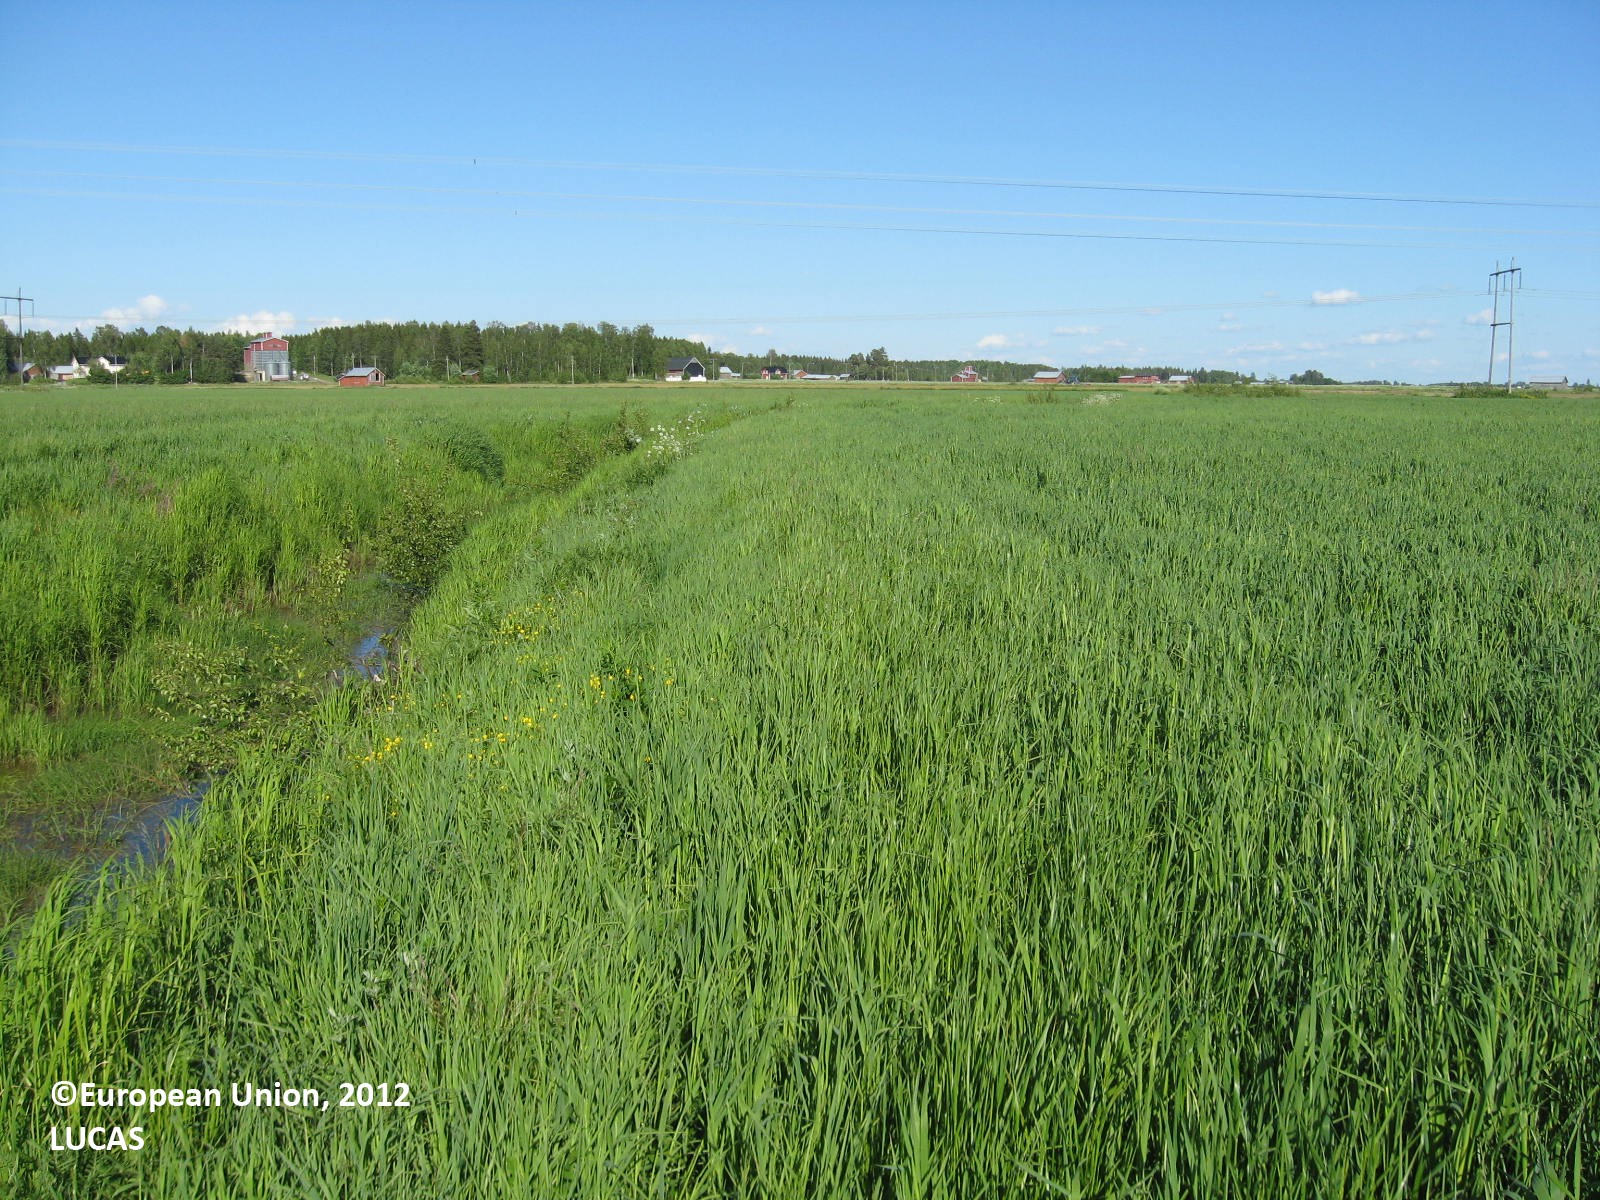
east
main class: Cropland
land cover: Temporary grasslands
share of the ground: > 75 %
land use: Agriculture (excluding fallow land and kitchen gardens)
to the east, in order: Temporary grasslands; Grass margins; Ditches and canals; Grass margins; Temporary grasslands; Electric lines; Barley; Electric lines; Barley
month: June
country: FI
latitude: 63.0030
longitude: 21.8314
